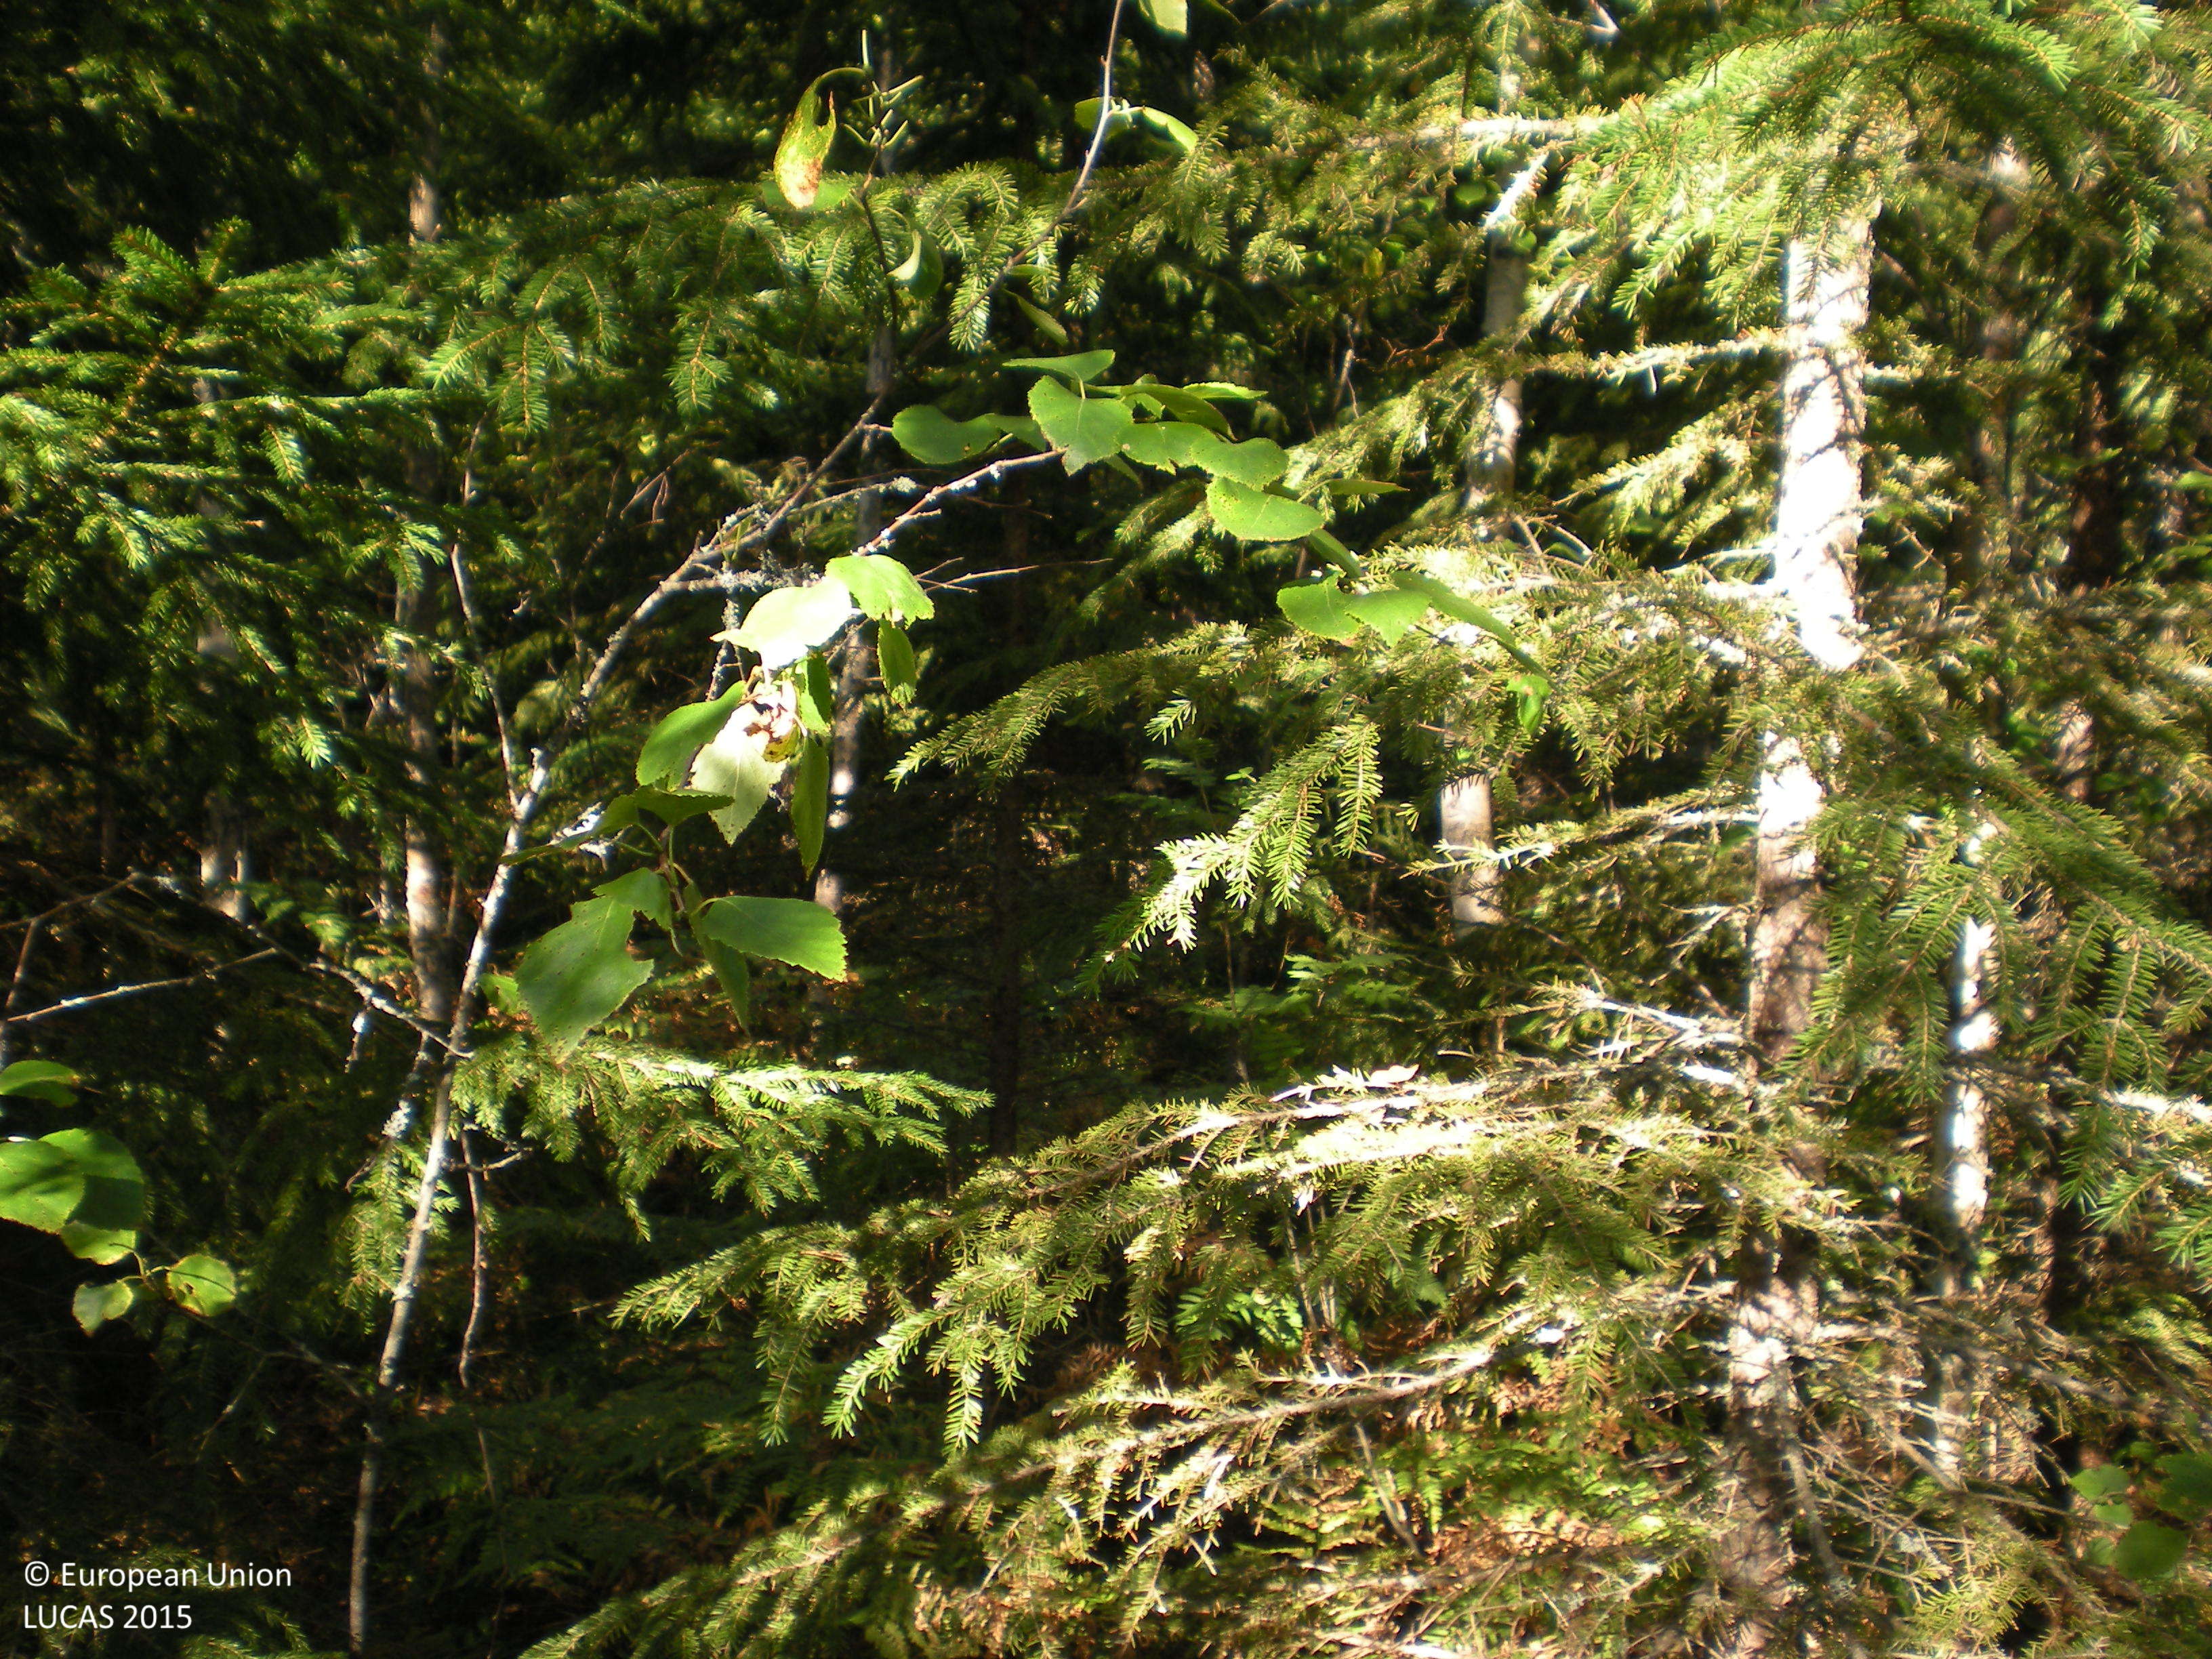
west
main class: Woodland
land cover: Spruce dominated mixed woodland
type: boreal forest
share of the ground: > 75 %
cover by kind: coniferous forest trees 55 %, broadleaved forest trees 25 %, herbaceous plants 10 %, shrubs 5 %, lichens and mosses 5 %
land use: Forestry
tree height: > 5 m
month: August
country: SE
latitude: 60.6293
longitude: 17.2094
